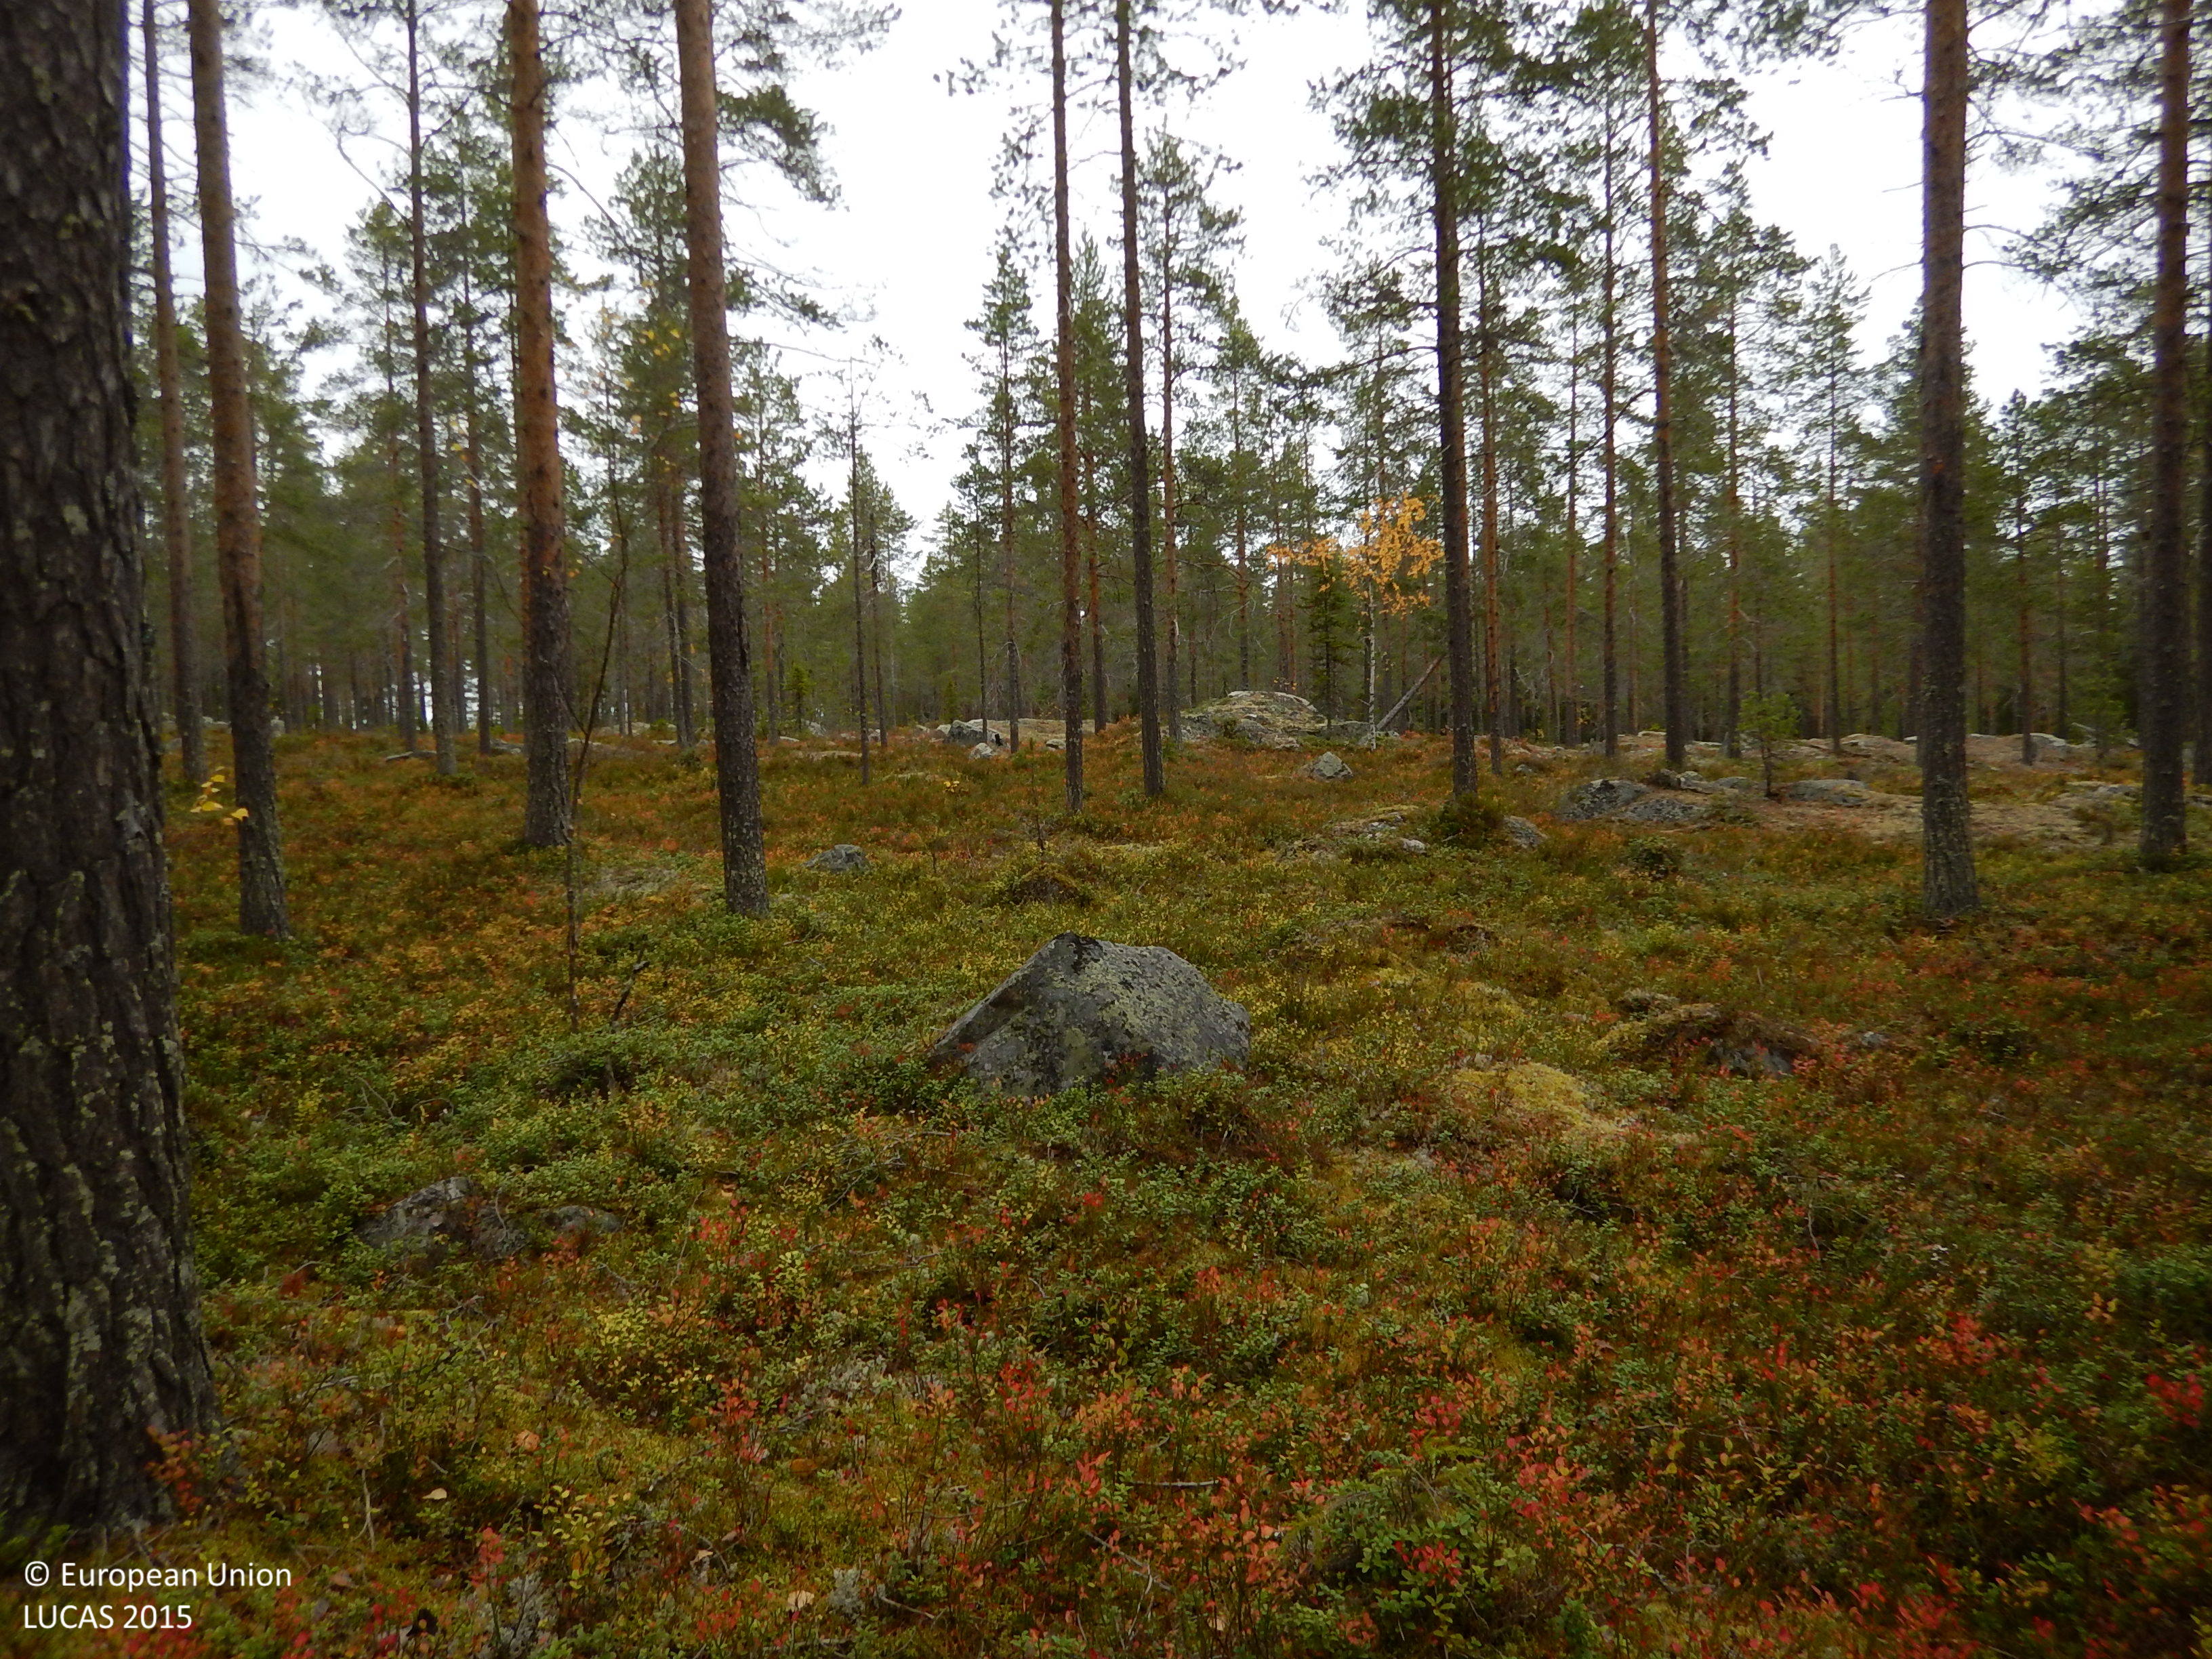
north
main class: Woodland
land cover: Pine dominated coniferous woodland
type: boreal forest
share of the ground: 50 - 75 %
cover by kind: coniferous forest trees 65 %, shrubs 15 %, lichens and mosses 15 %, herbaceous plants 5 %
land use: Forestry
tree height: > 5 m
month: October
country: SE
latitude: 64.9616
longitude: 21.0517
